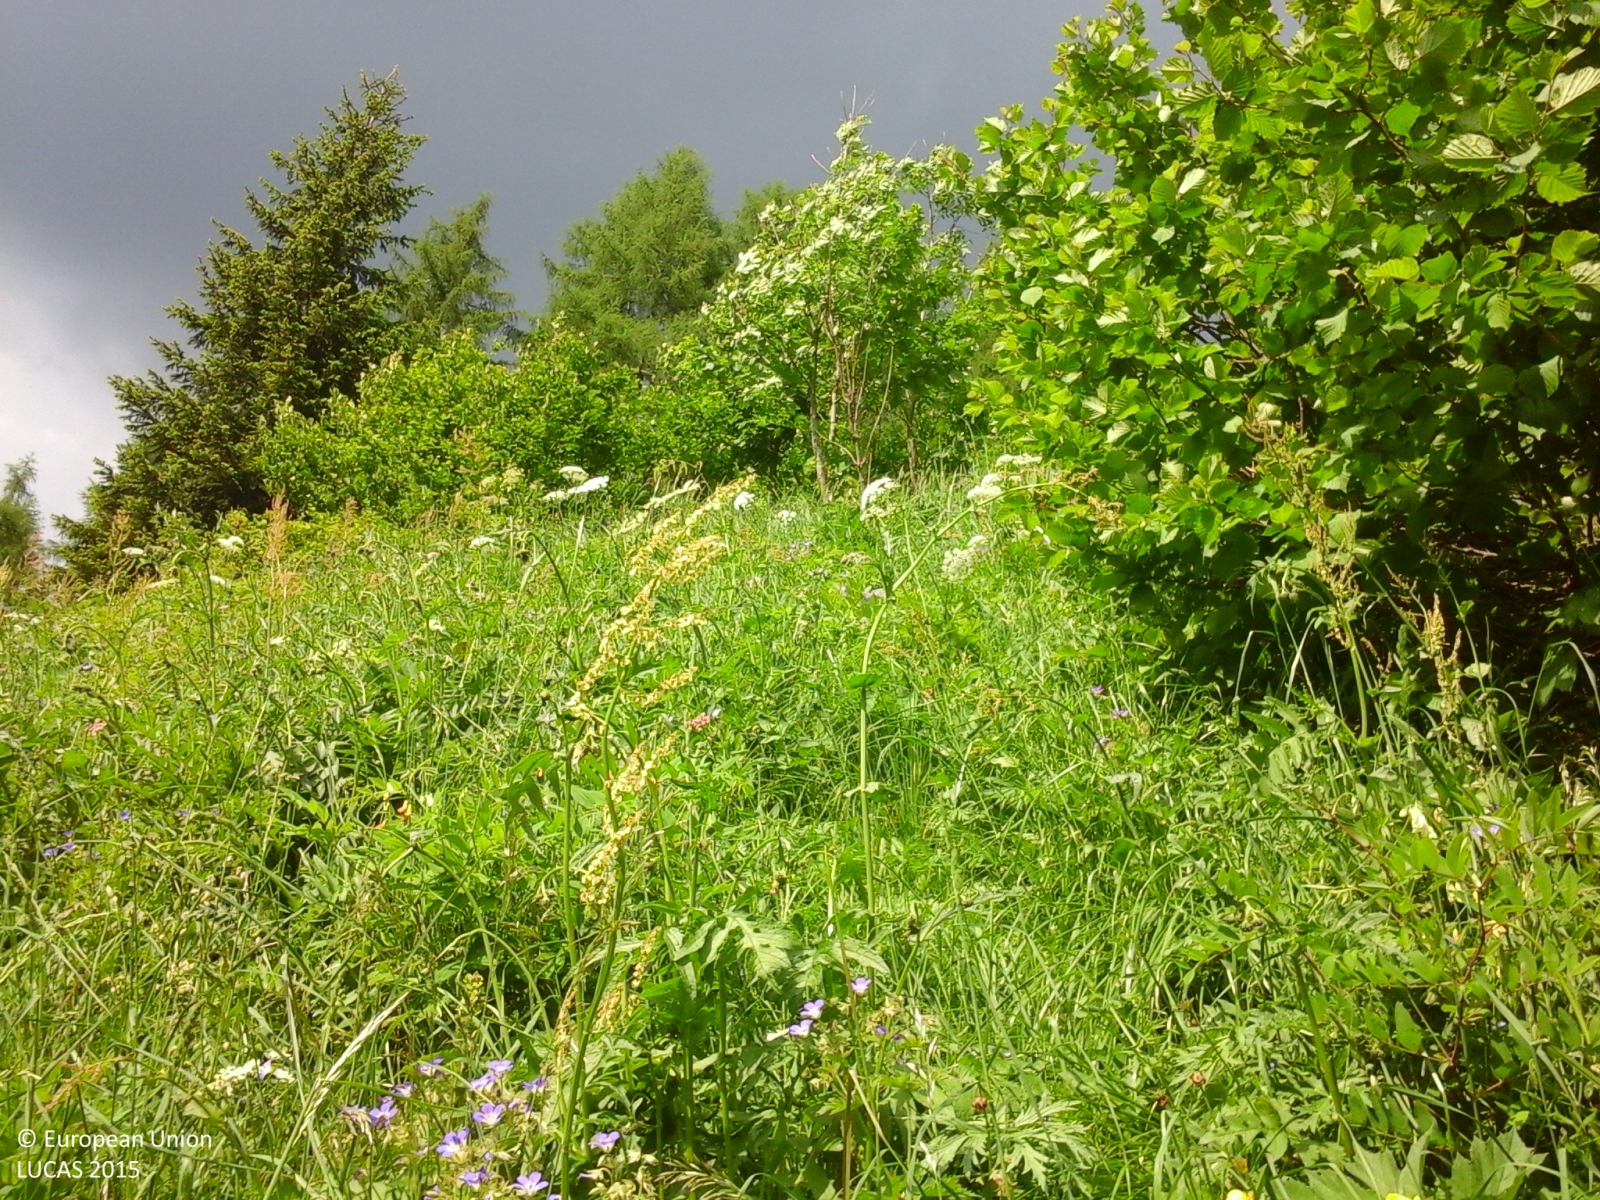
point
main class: Grassland
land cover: Grassland with sparse tree/shrub cover
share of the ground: > 75 %
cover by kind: herbaceous plants 85 %, shrubs 10 %, coniferous forest trees 5 %
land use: Agriculture (excluding fallow land and kitchen gardens)
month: June
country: IT
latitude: 46.3838
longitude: 12.1429
